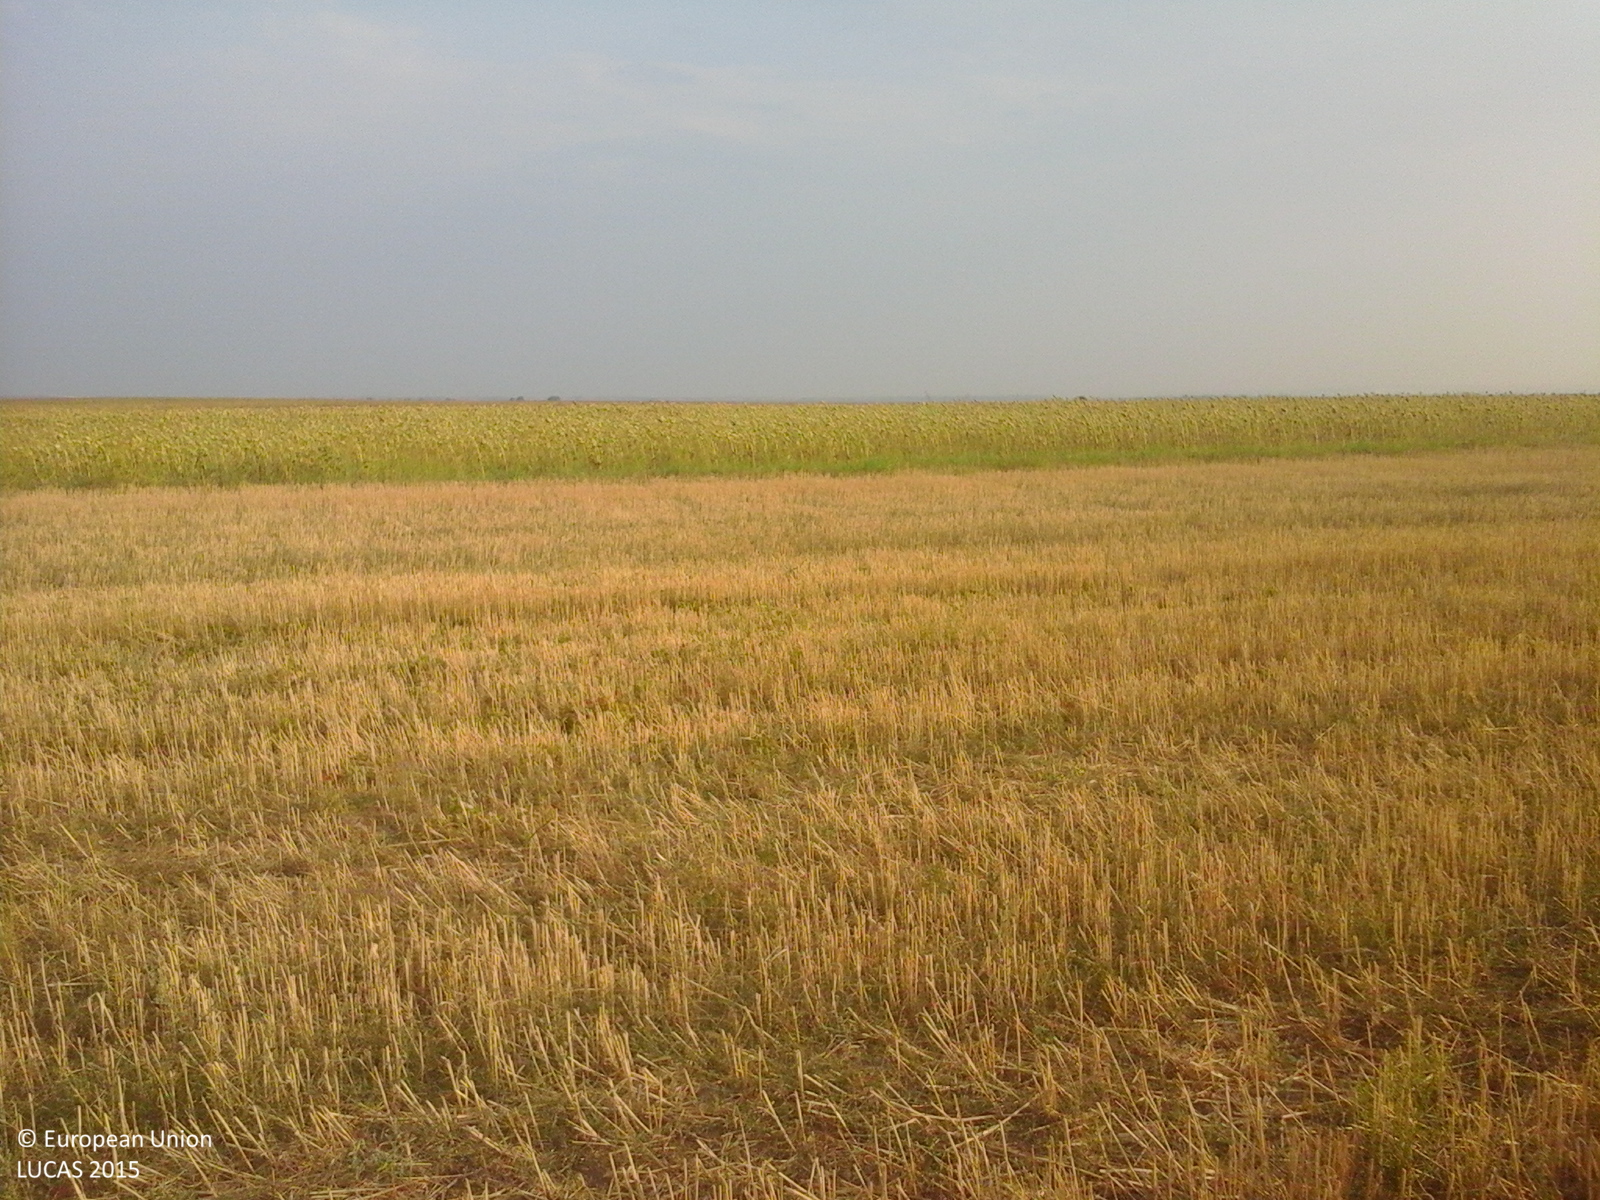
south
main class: Cropland
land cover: Sunflower
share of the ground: > 75 %
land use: Agriculture (excluding fallow land and kitchen gardens)
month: August
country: RO
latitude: 44.3173
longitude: 22.9702
